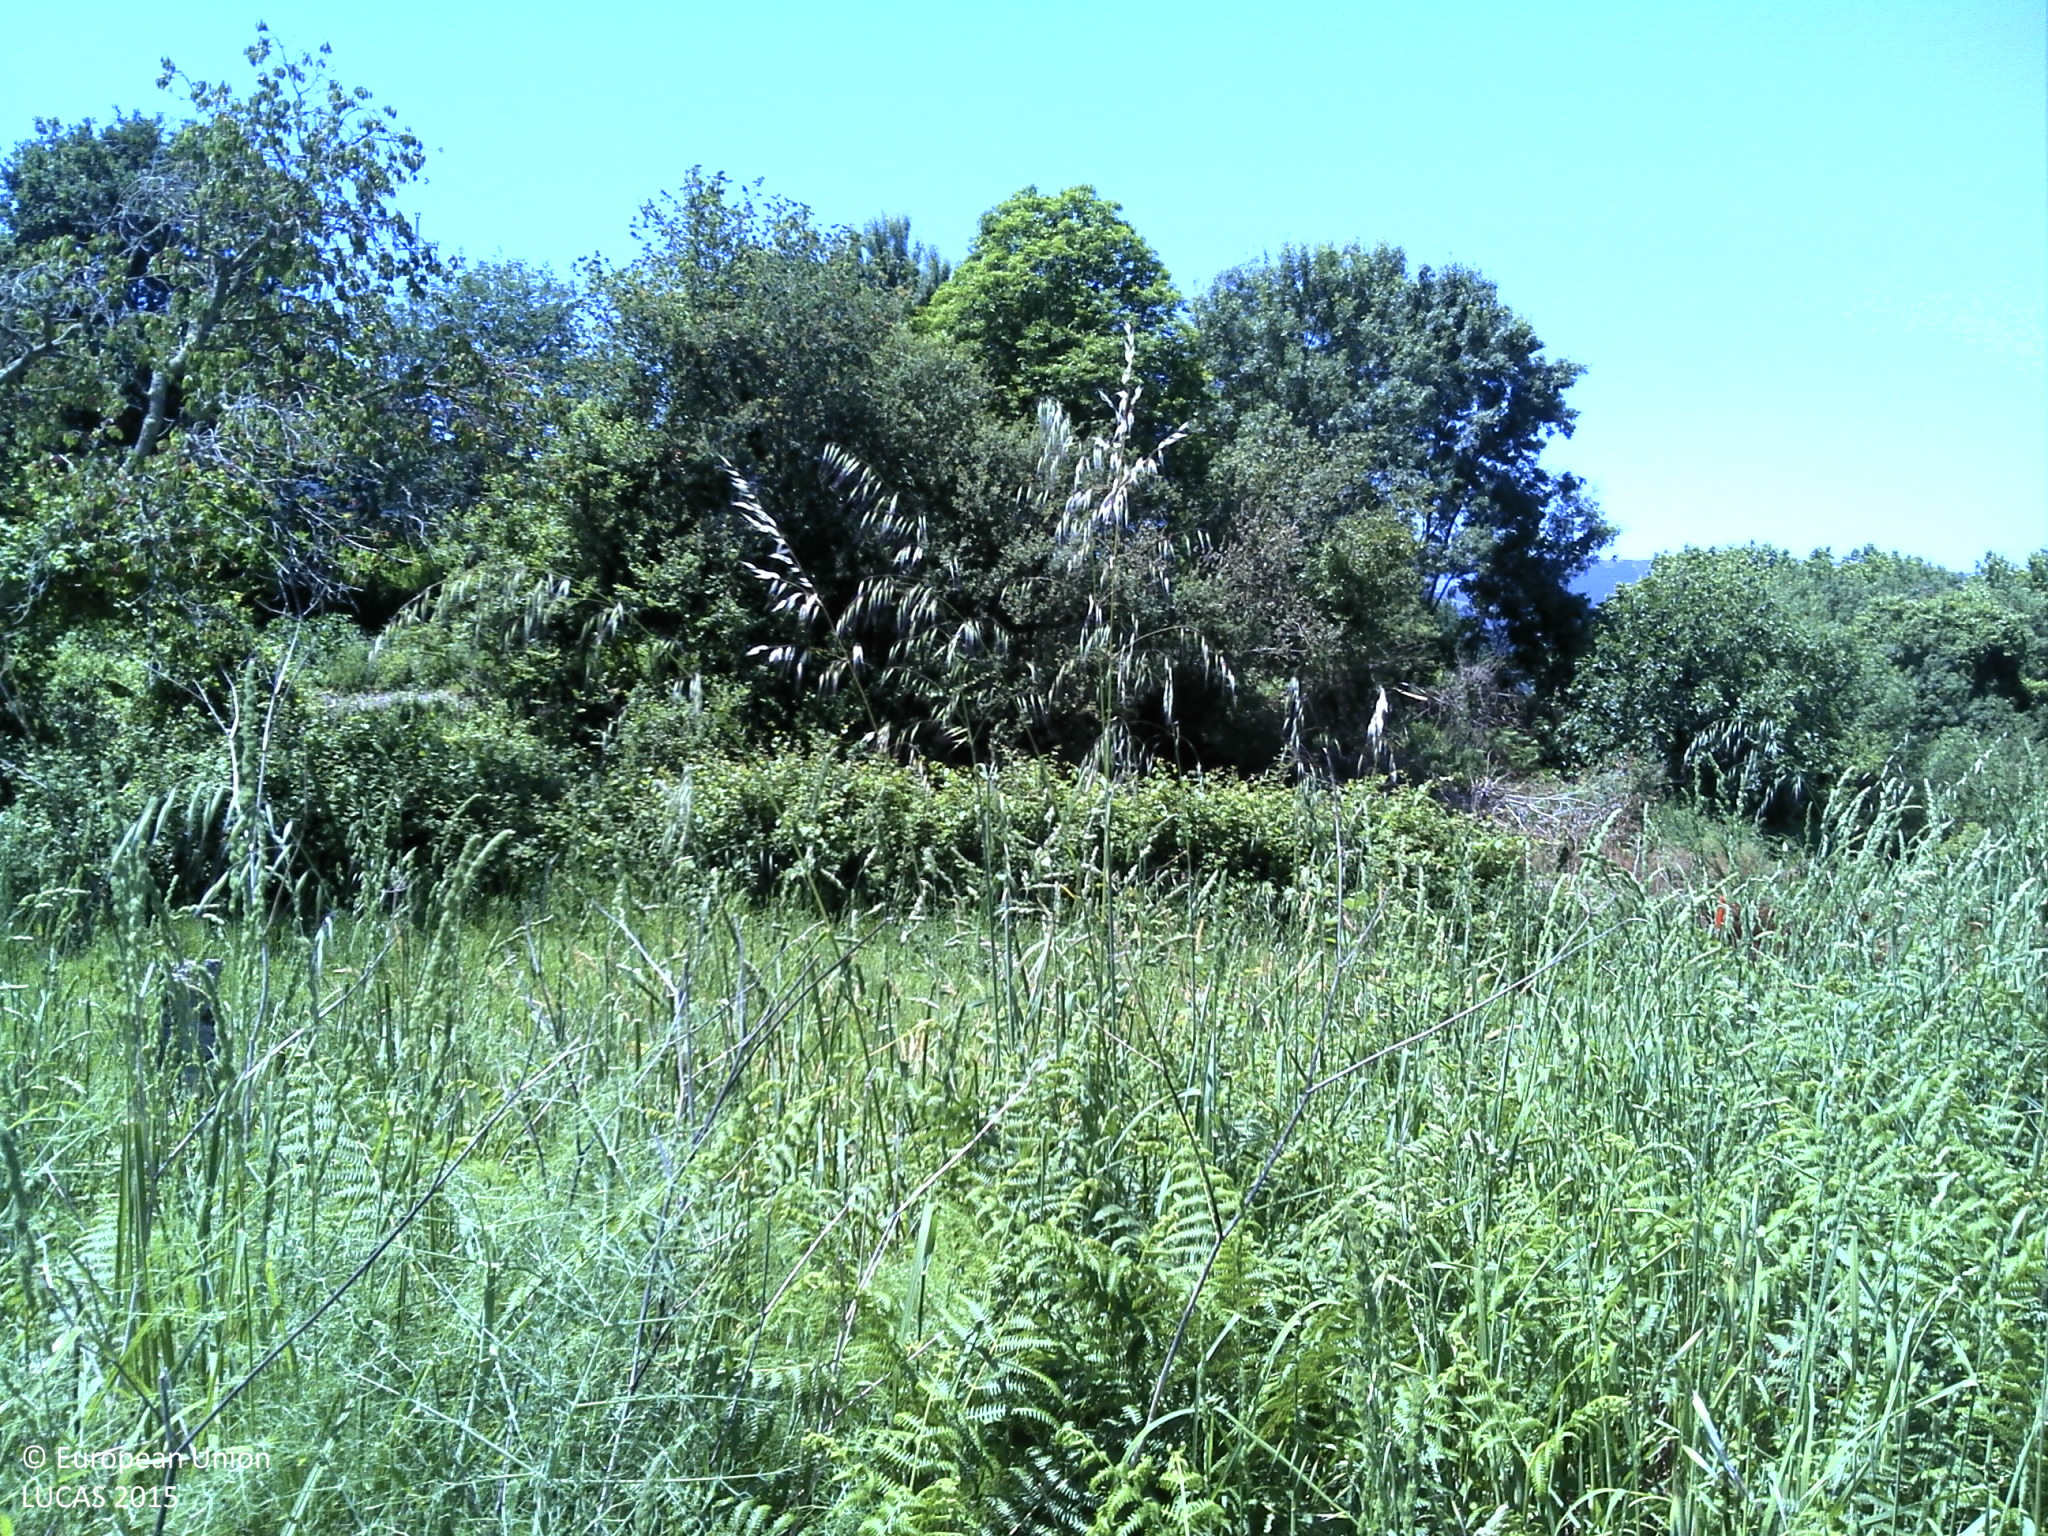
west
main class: Shrubland
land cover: Shrubland without tree cover
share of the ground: 50 - 75 %
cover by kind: shrubs 50 %, herbaceous plants 40 %, unconsolidated bare surface 10 %
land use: Abandoned areas
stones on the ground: < 10 %
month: May
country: PT
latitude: 41.9197
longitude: -8.7506
